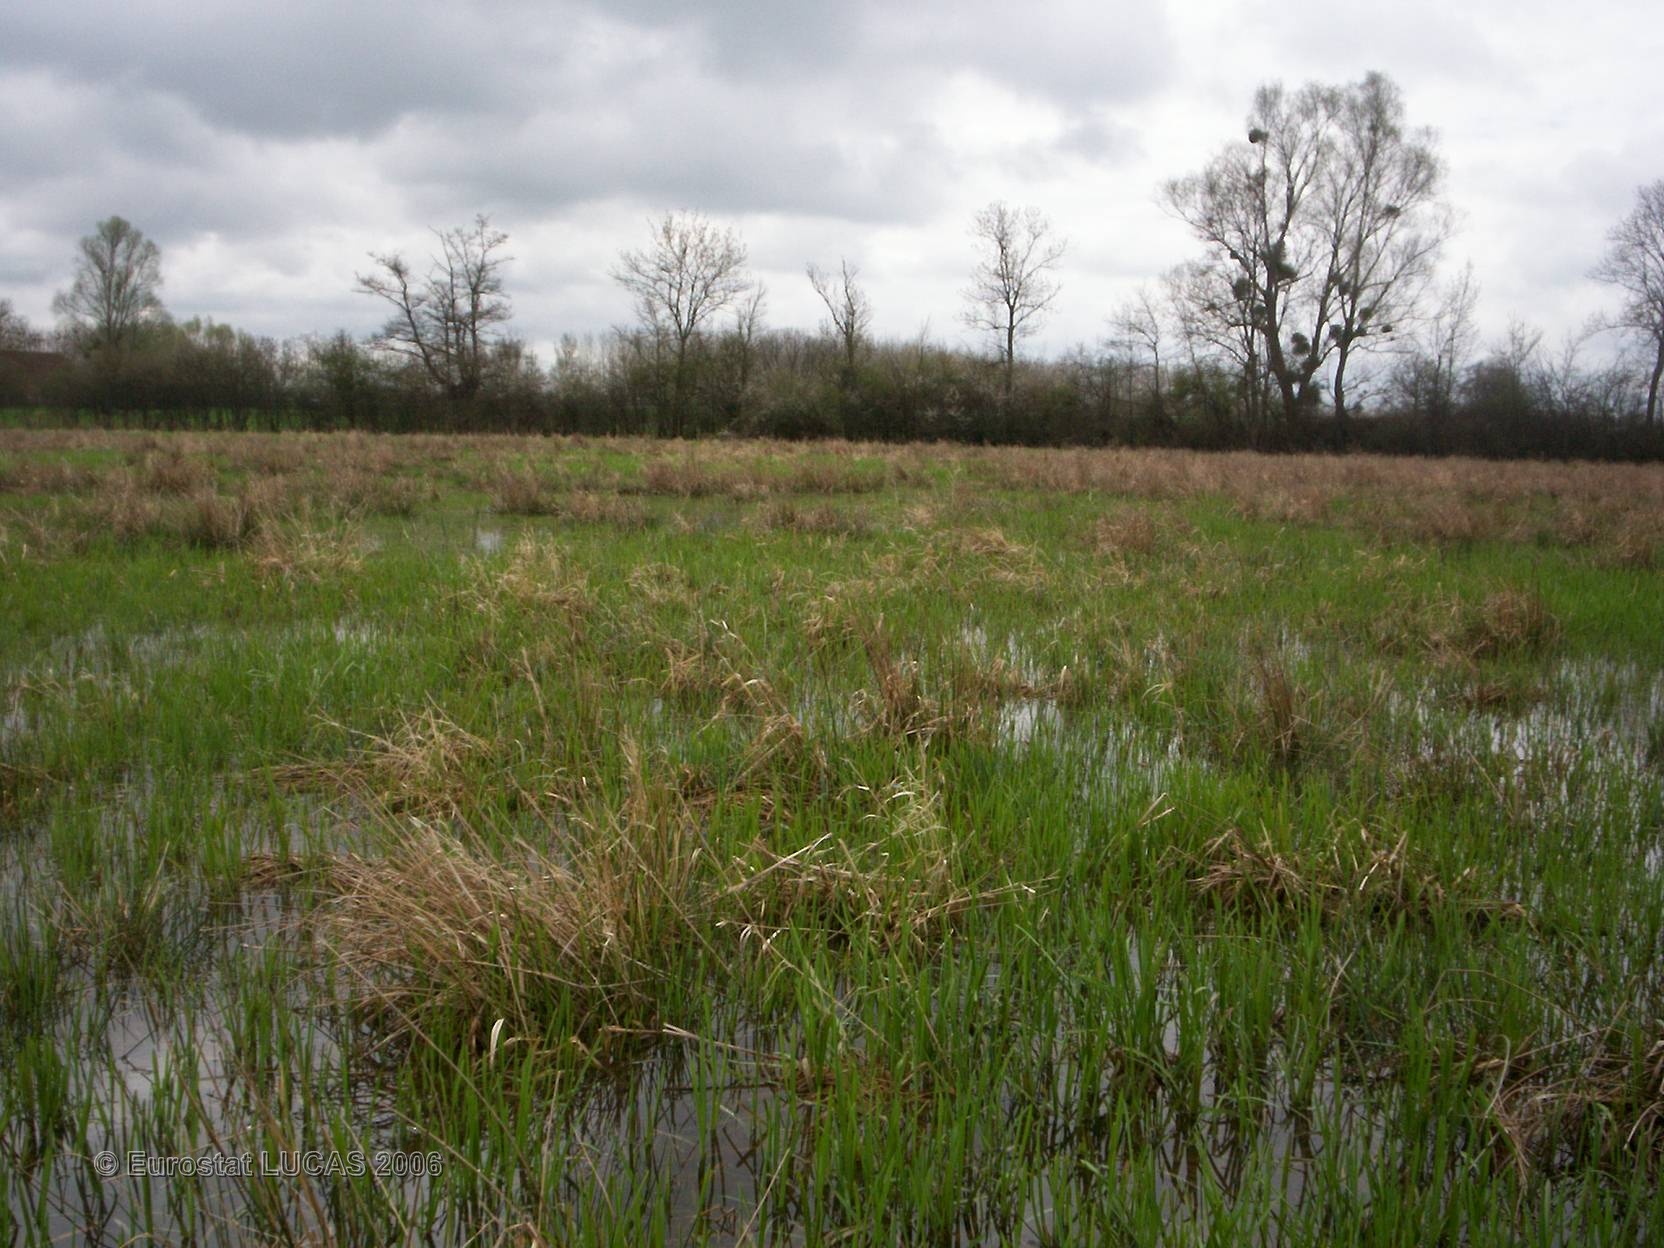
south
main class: Grassland
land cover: Grassland without tree/shrub cover
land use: Agriculture (excluding fallow land and kitchen gardens)
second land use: Wetland
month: April
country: FR
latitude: 46.8127
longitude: 3.0637
